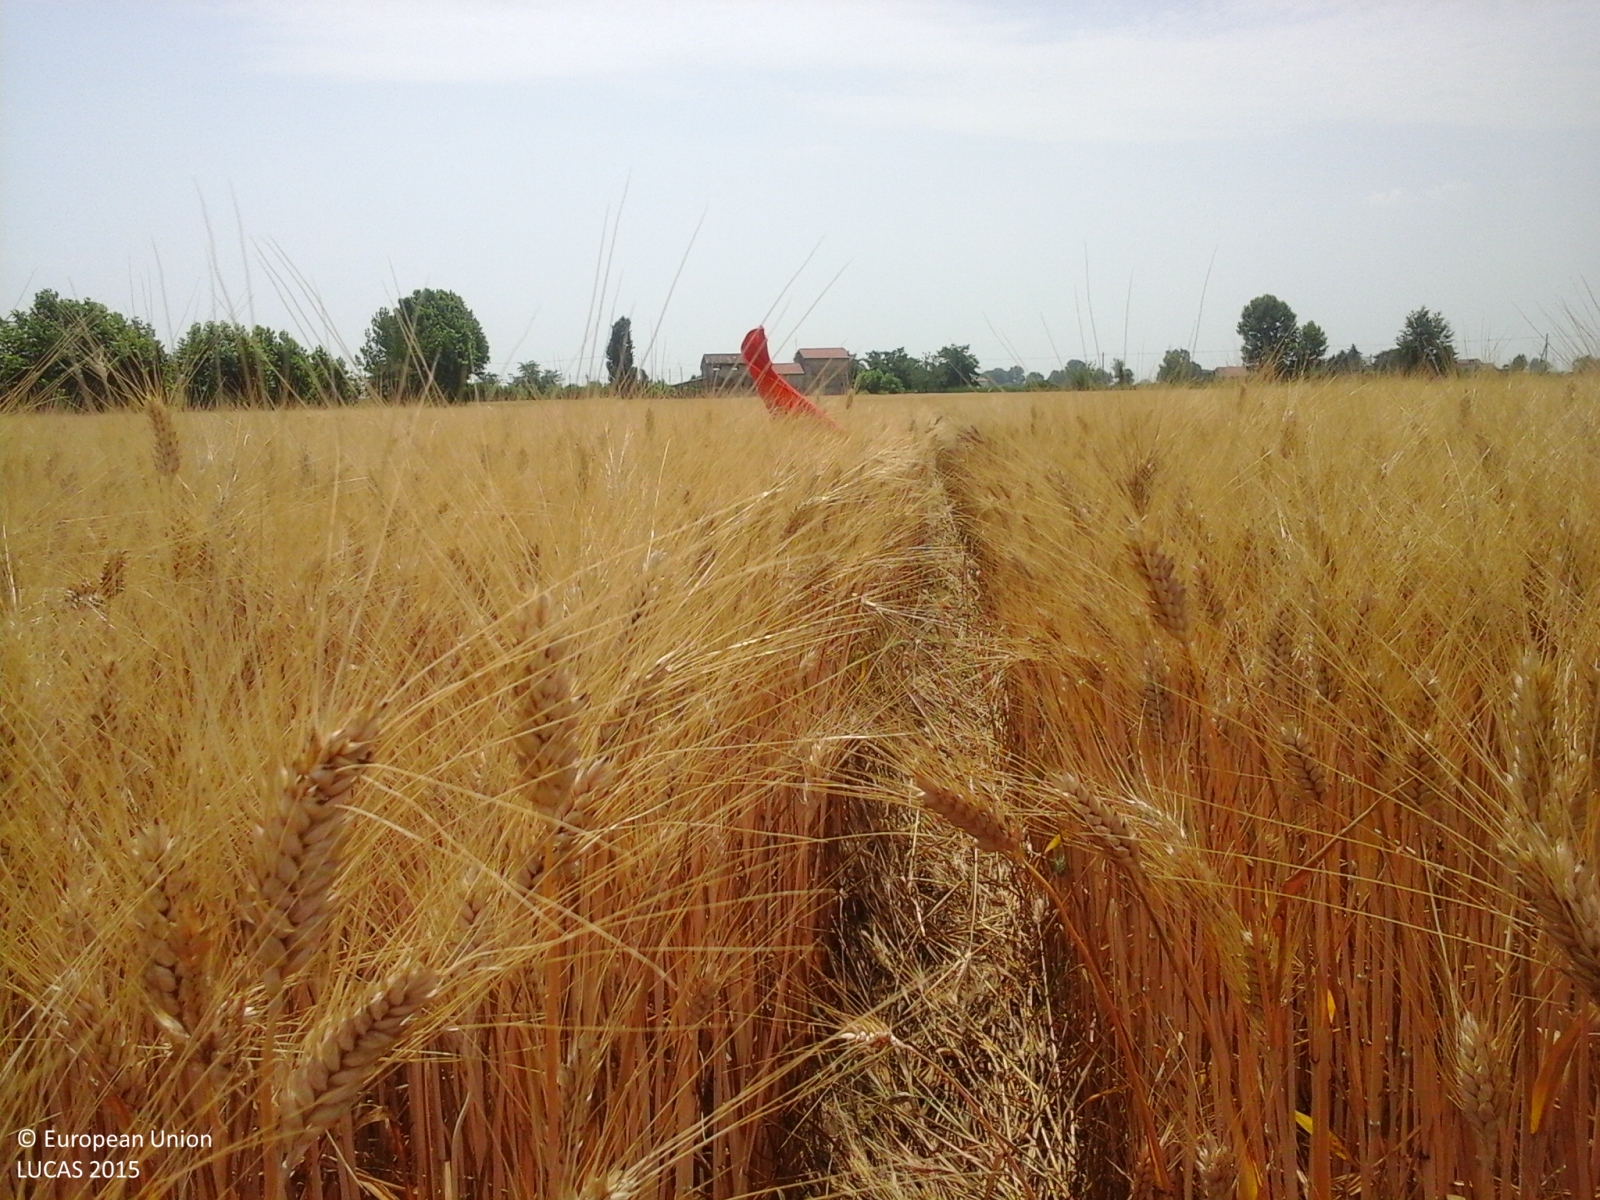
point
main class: Cropland
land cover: Durum wheat
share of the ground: > 75 %
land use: Agriculture (excluding fallow land and kitchen gardens)
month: June
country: IT
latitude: 45.2651
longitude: 11.0305
